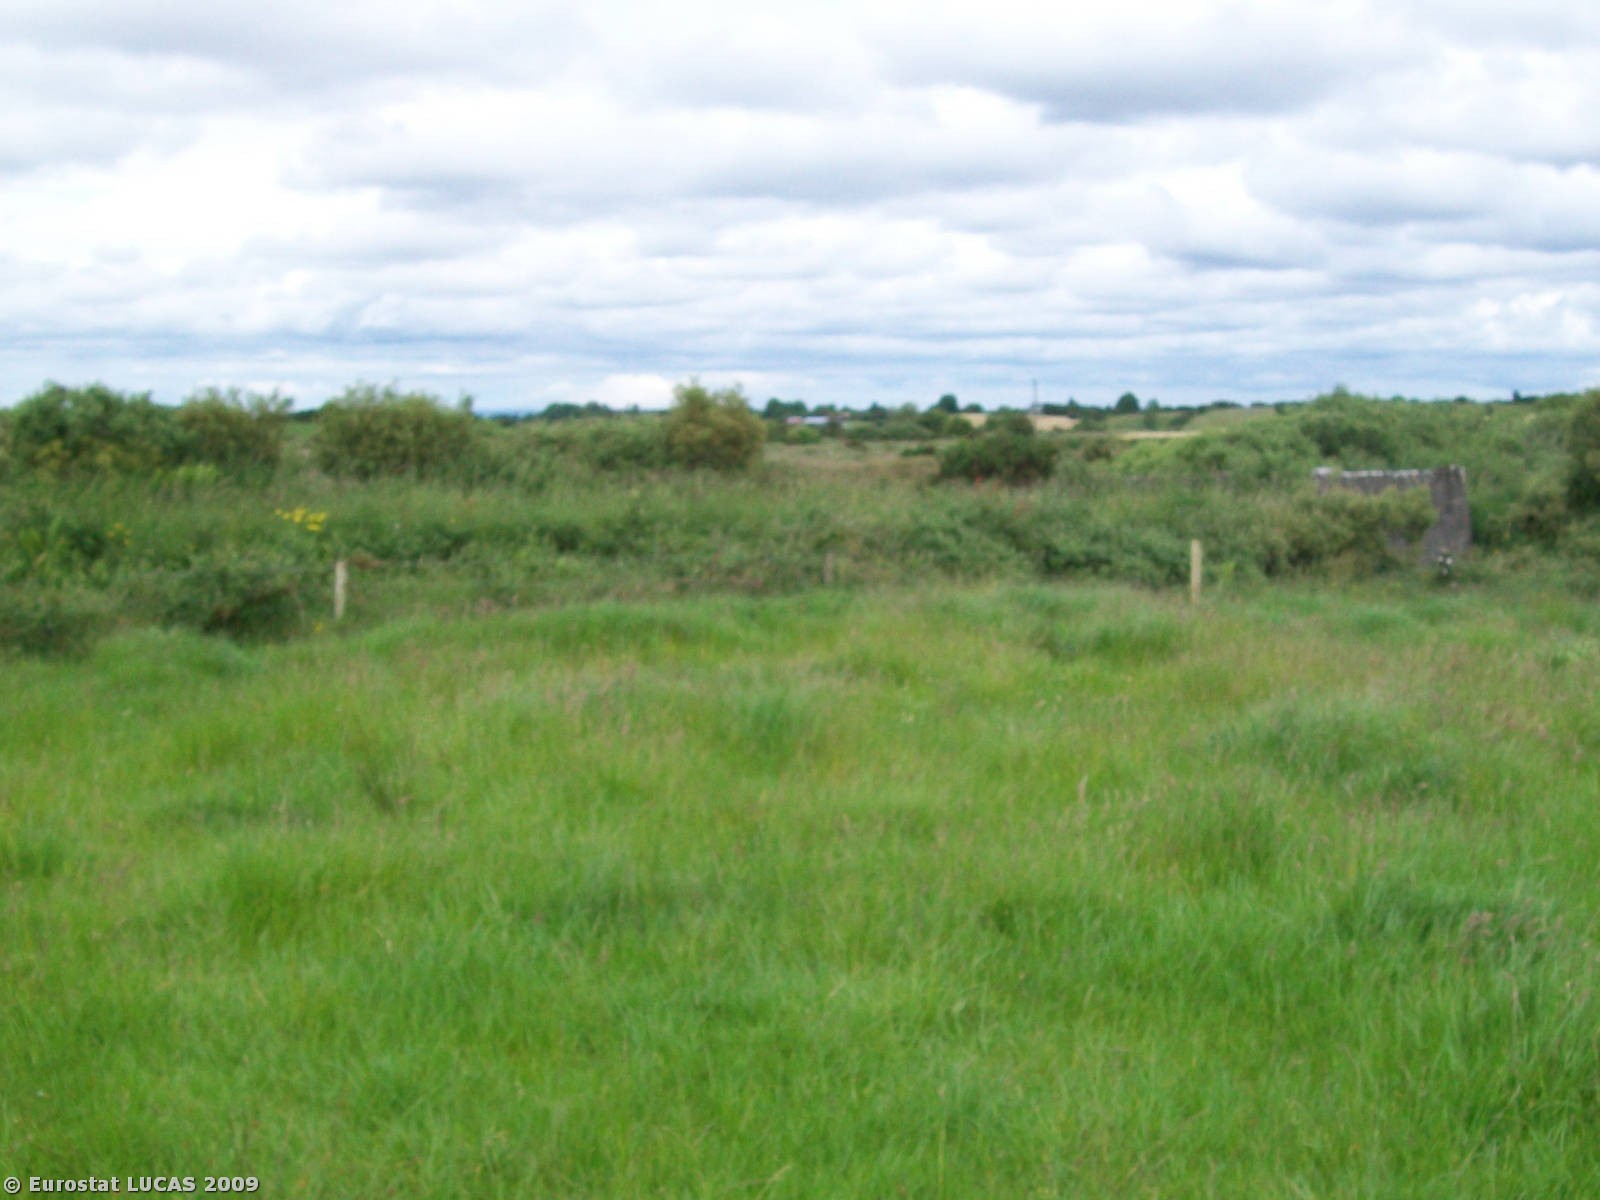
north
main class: Artificial land
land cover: Non built-up linear features
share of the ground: > 75 %
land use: Road transport
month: June
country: IE
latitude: 53.8027
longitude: -8.9942
